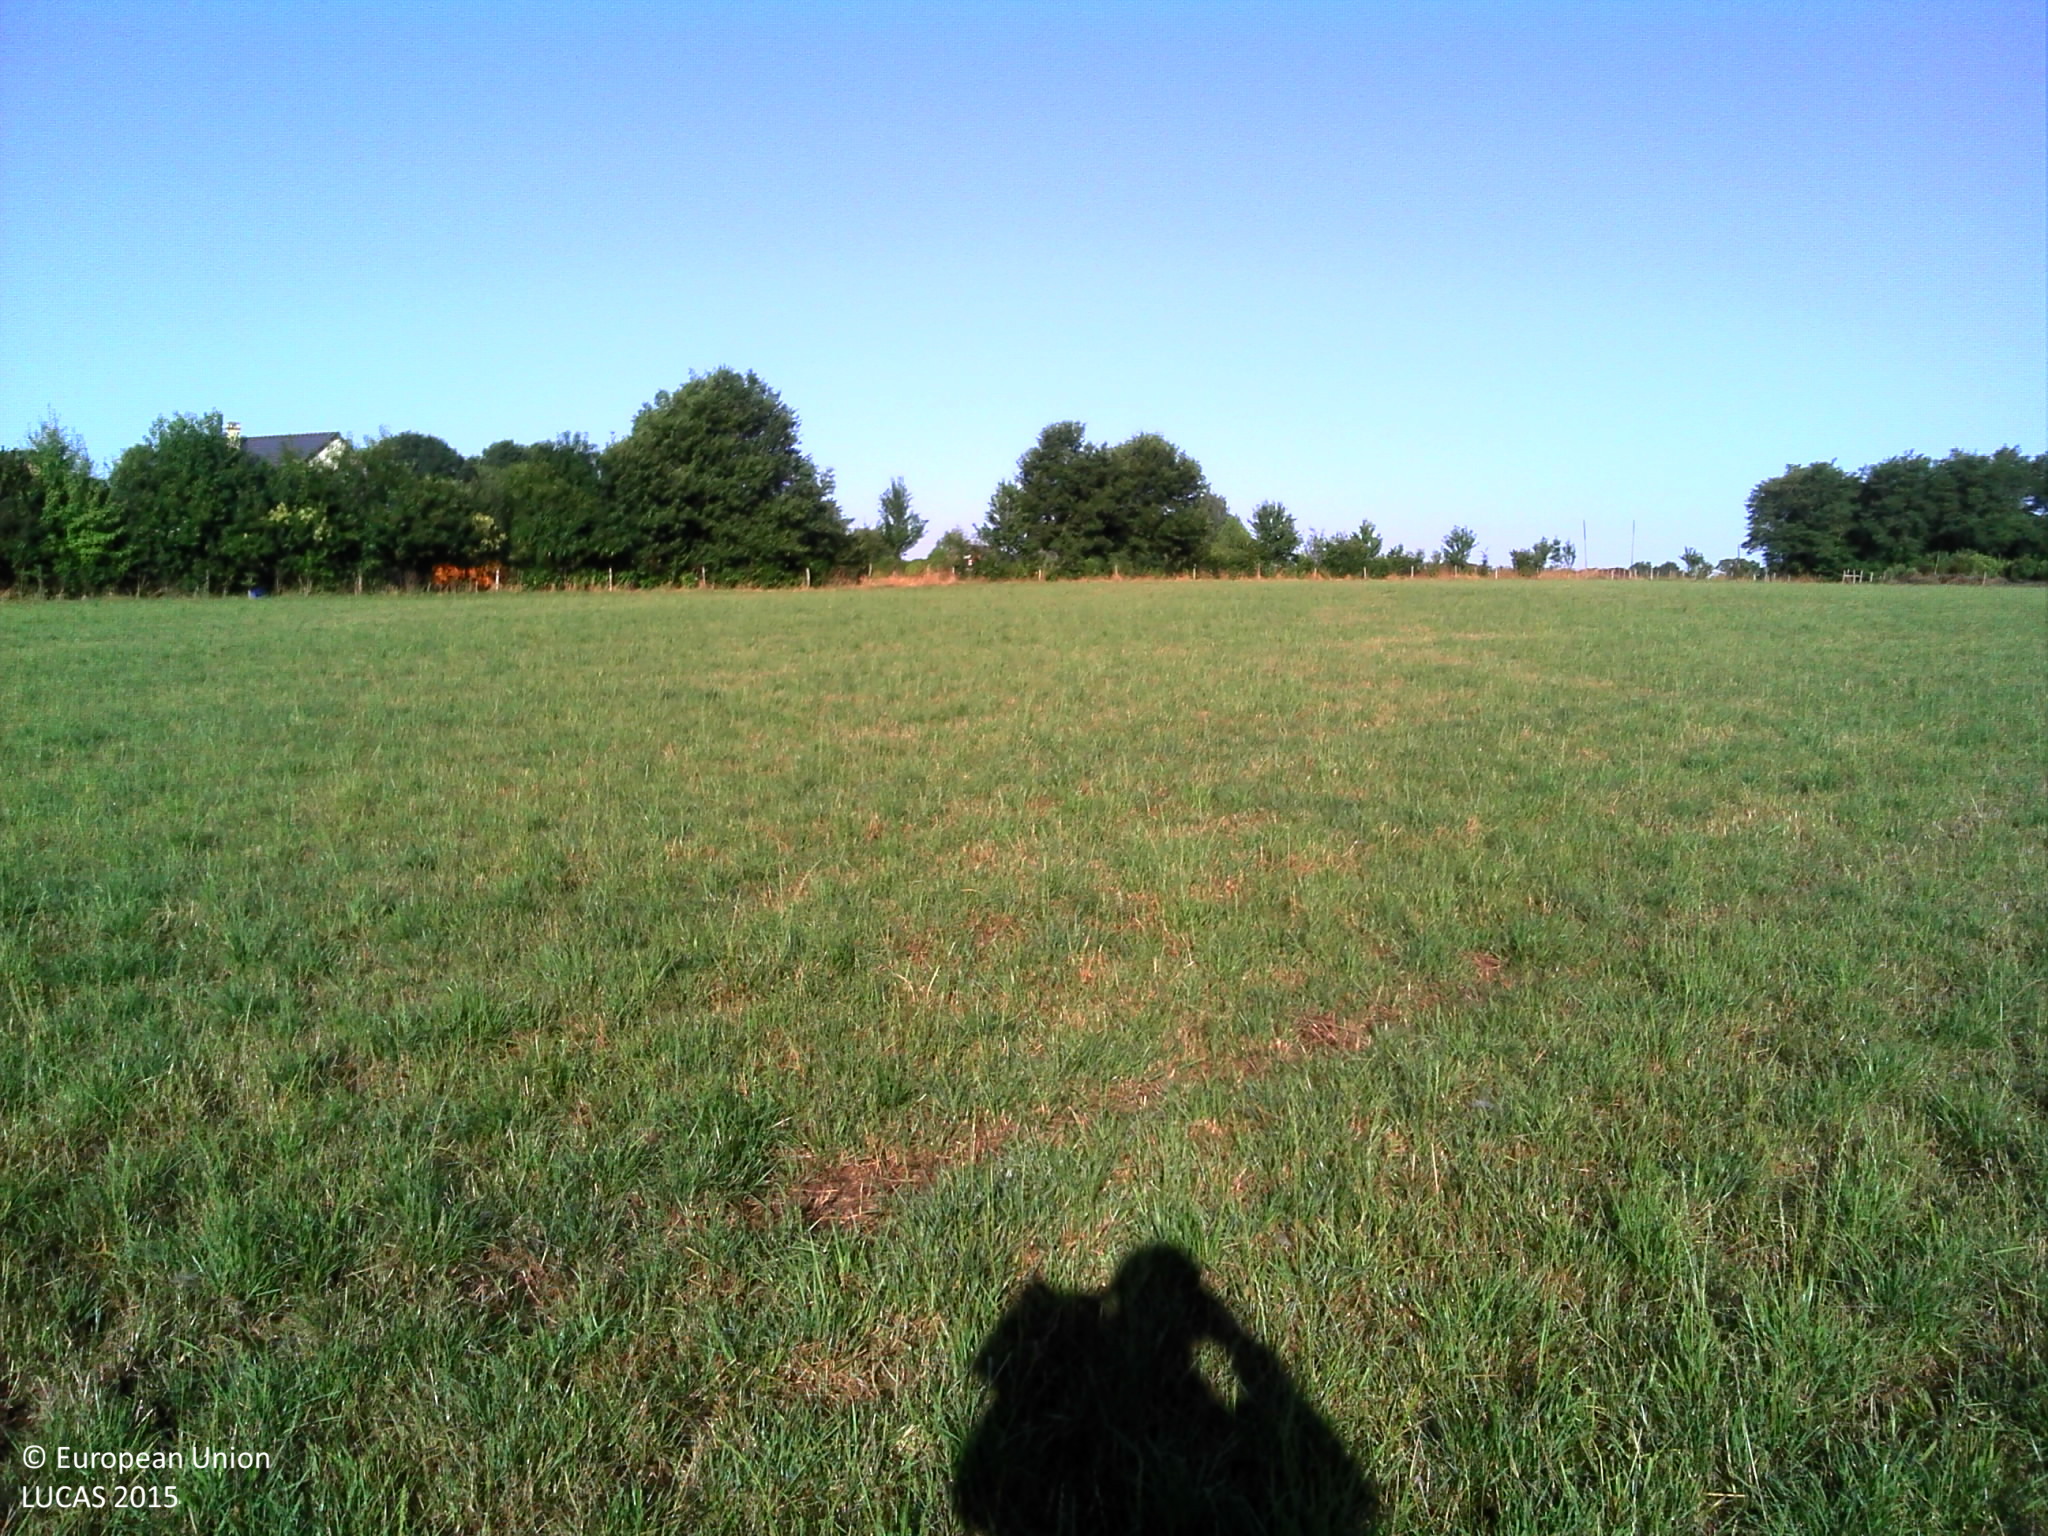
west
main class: Cropland
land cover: Temporary grasslands
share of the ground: > 75 %
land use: Agriculture (excluding fallow land and kitchen gardens)
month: July
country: FR
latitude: 47.6261
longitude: -1.6086
